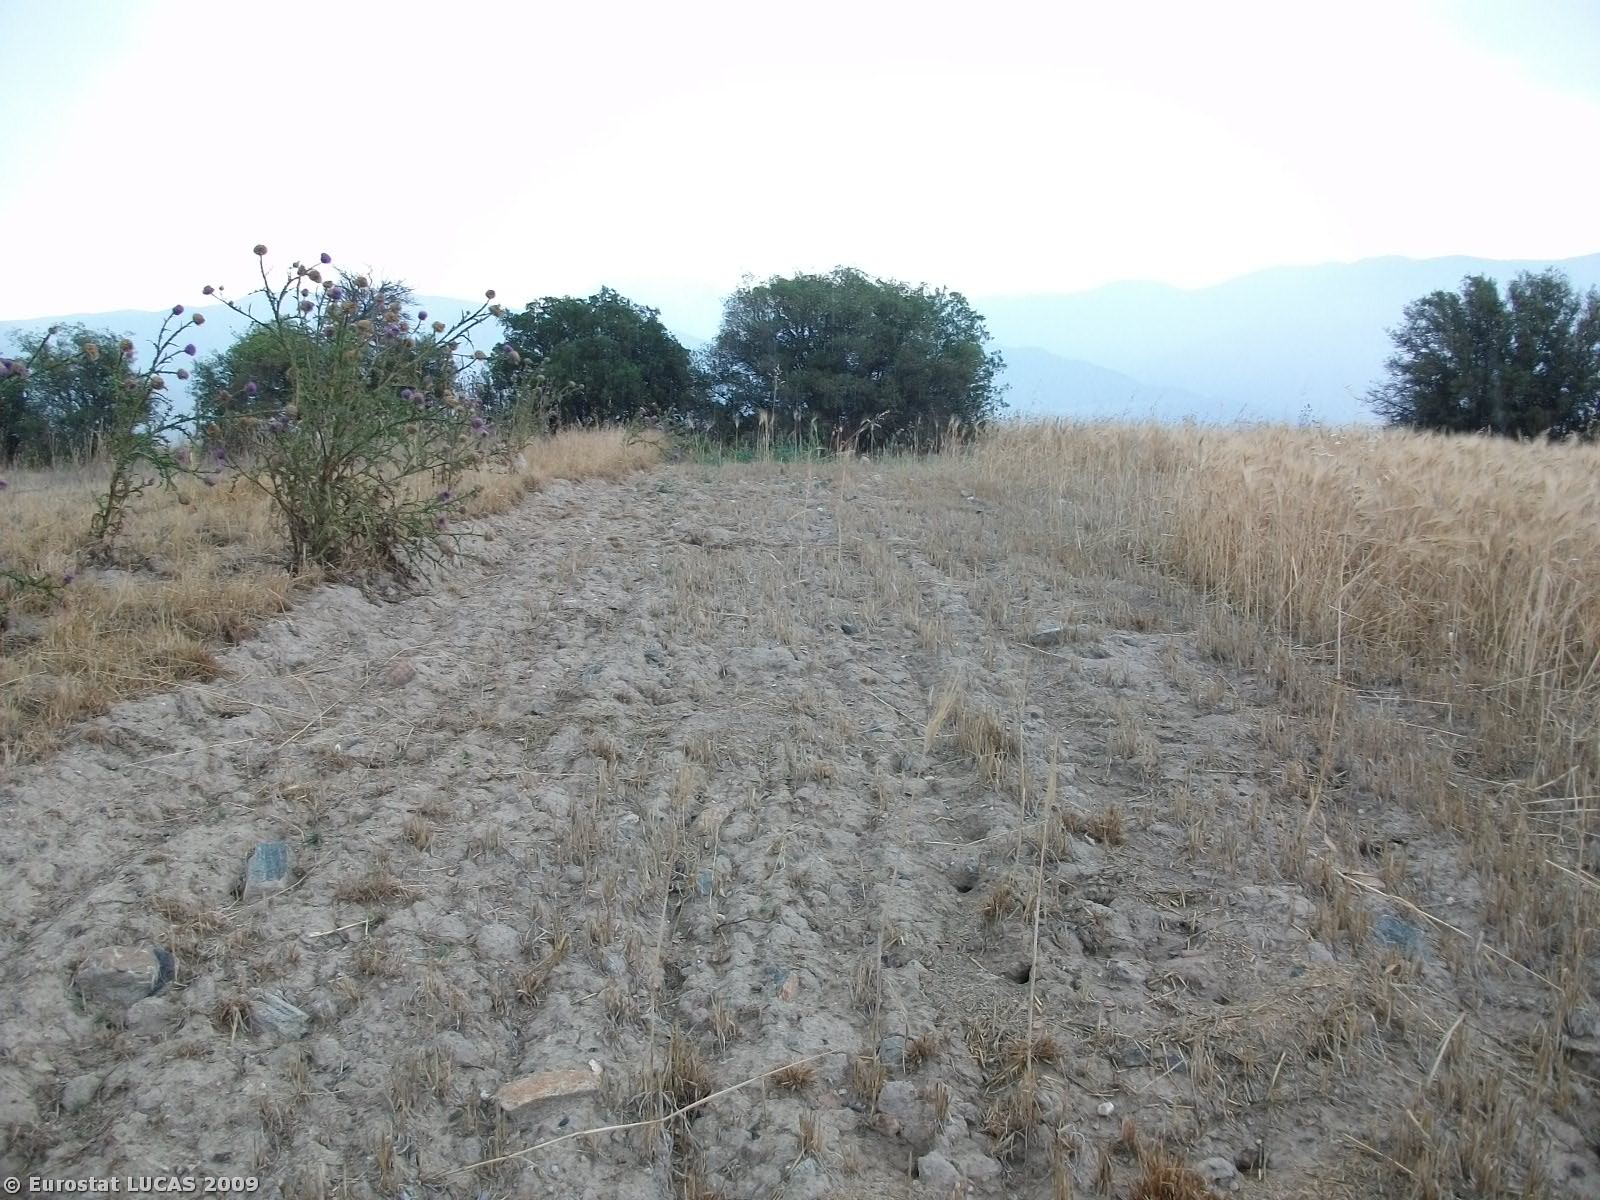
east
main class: Cropland
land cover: Durum wheat
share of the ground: < 10 %
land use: Agriculture (excluding fallow land and kitchen gardens)
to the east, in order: Durum wheat; Abandoned hedges; Paved roads, cycling and walking lanes; Durum wheat; Grassland without tree/shrub cover
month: June
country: GR
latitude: 39.7699
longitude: 22.5423
